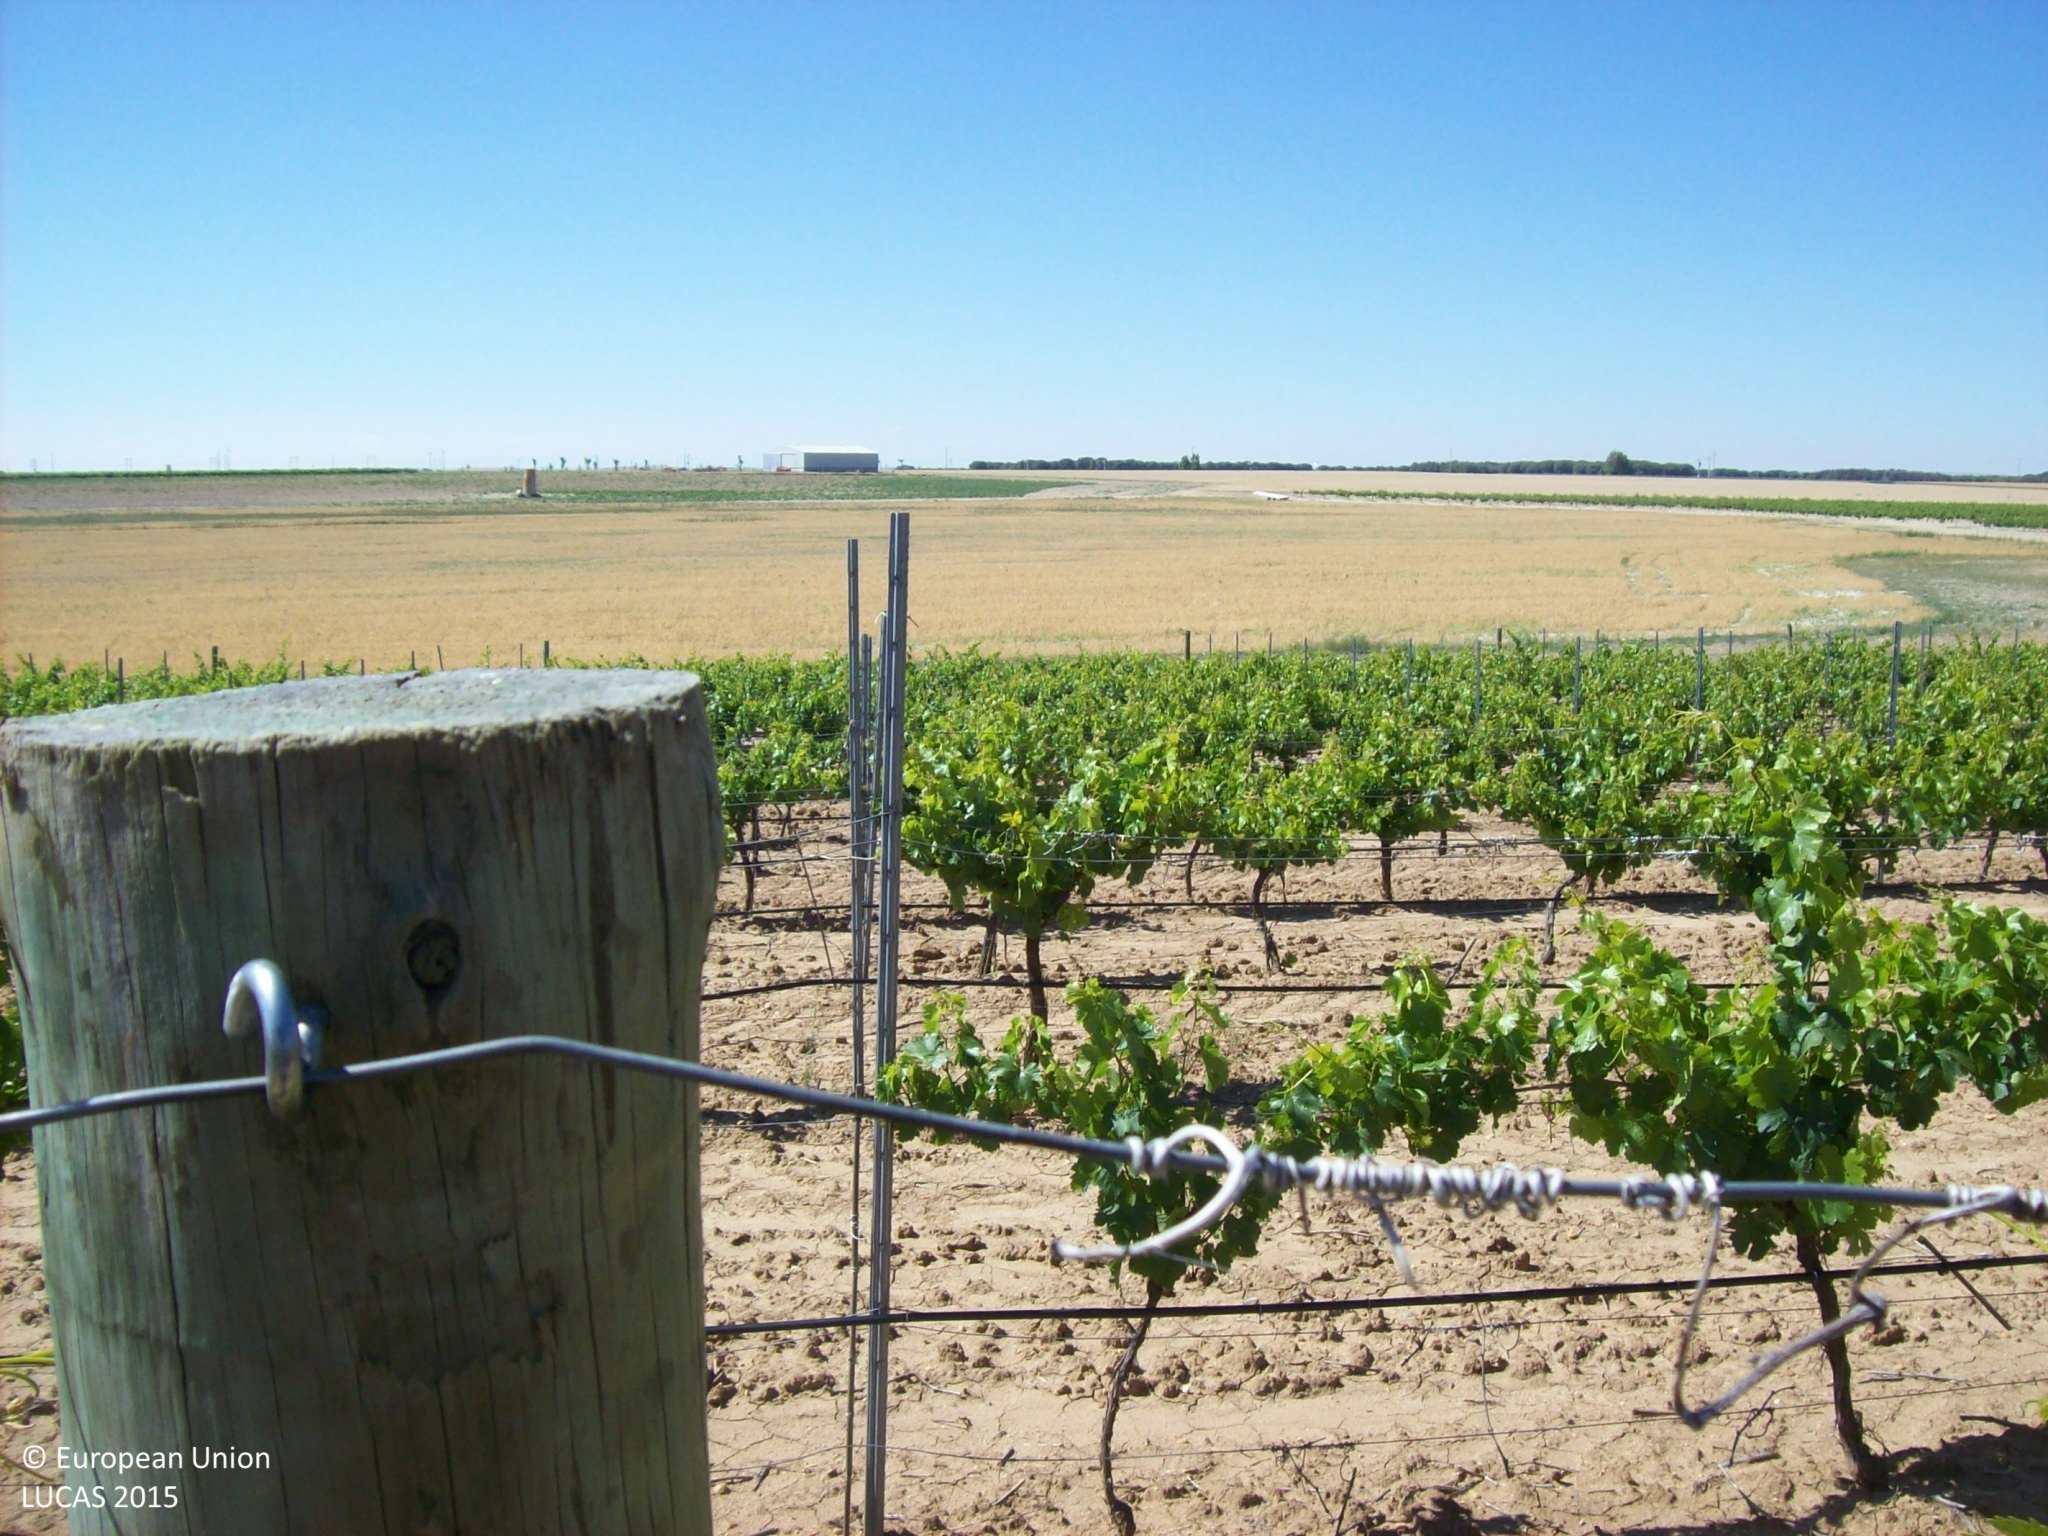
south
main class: Cropland
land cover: Vineyards
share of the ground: 25 - 50 %
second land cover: Other bare soil
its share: > 75 %
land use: Agriculture (excluding fallow land and kitchen gardens)
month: June
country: ES
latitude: 41.2688
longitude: -5.0267
